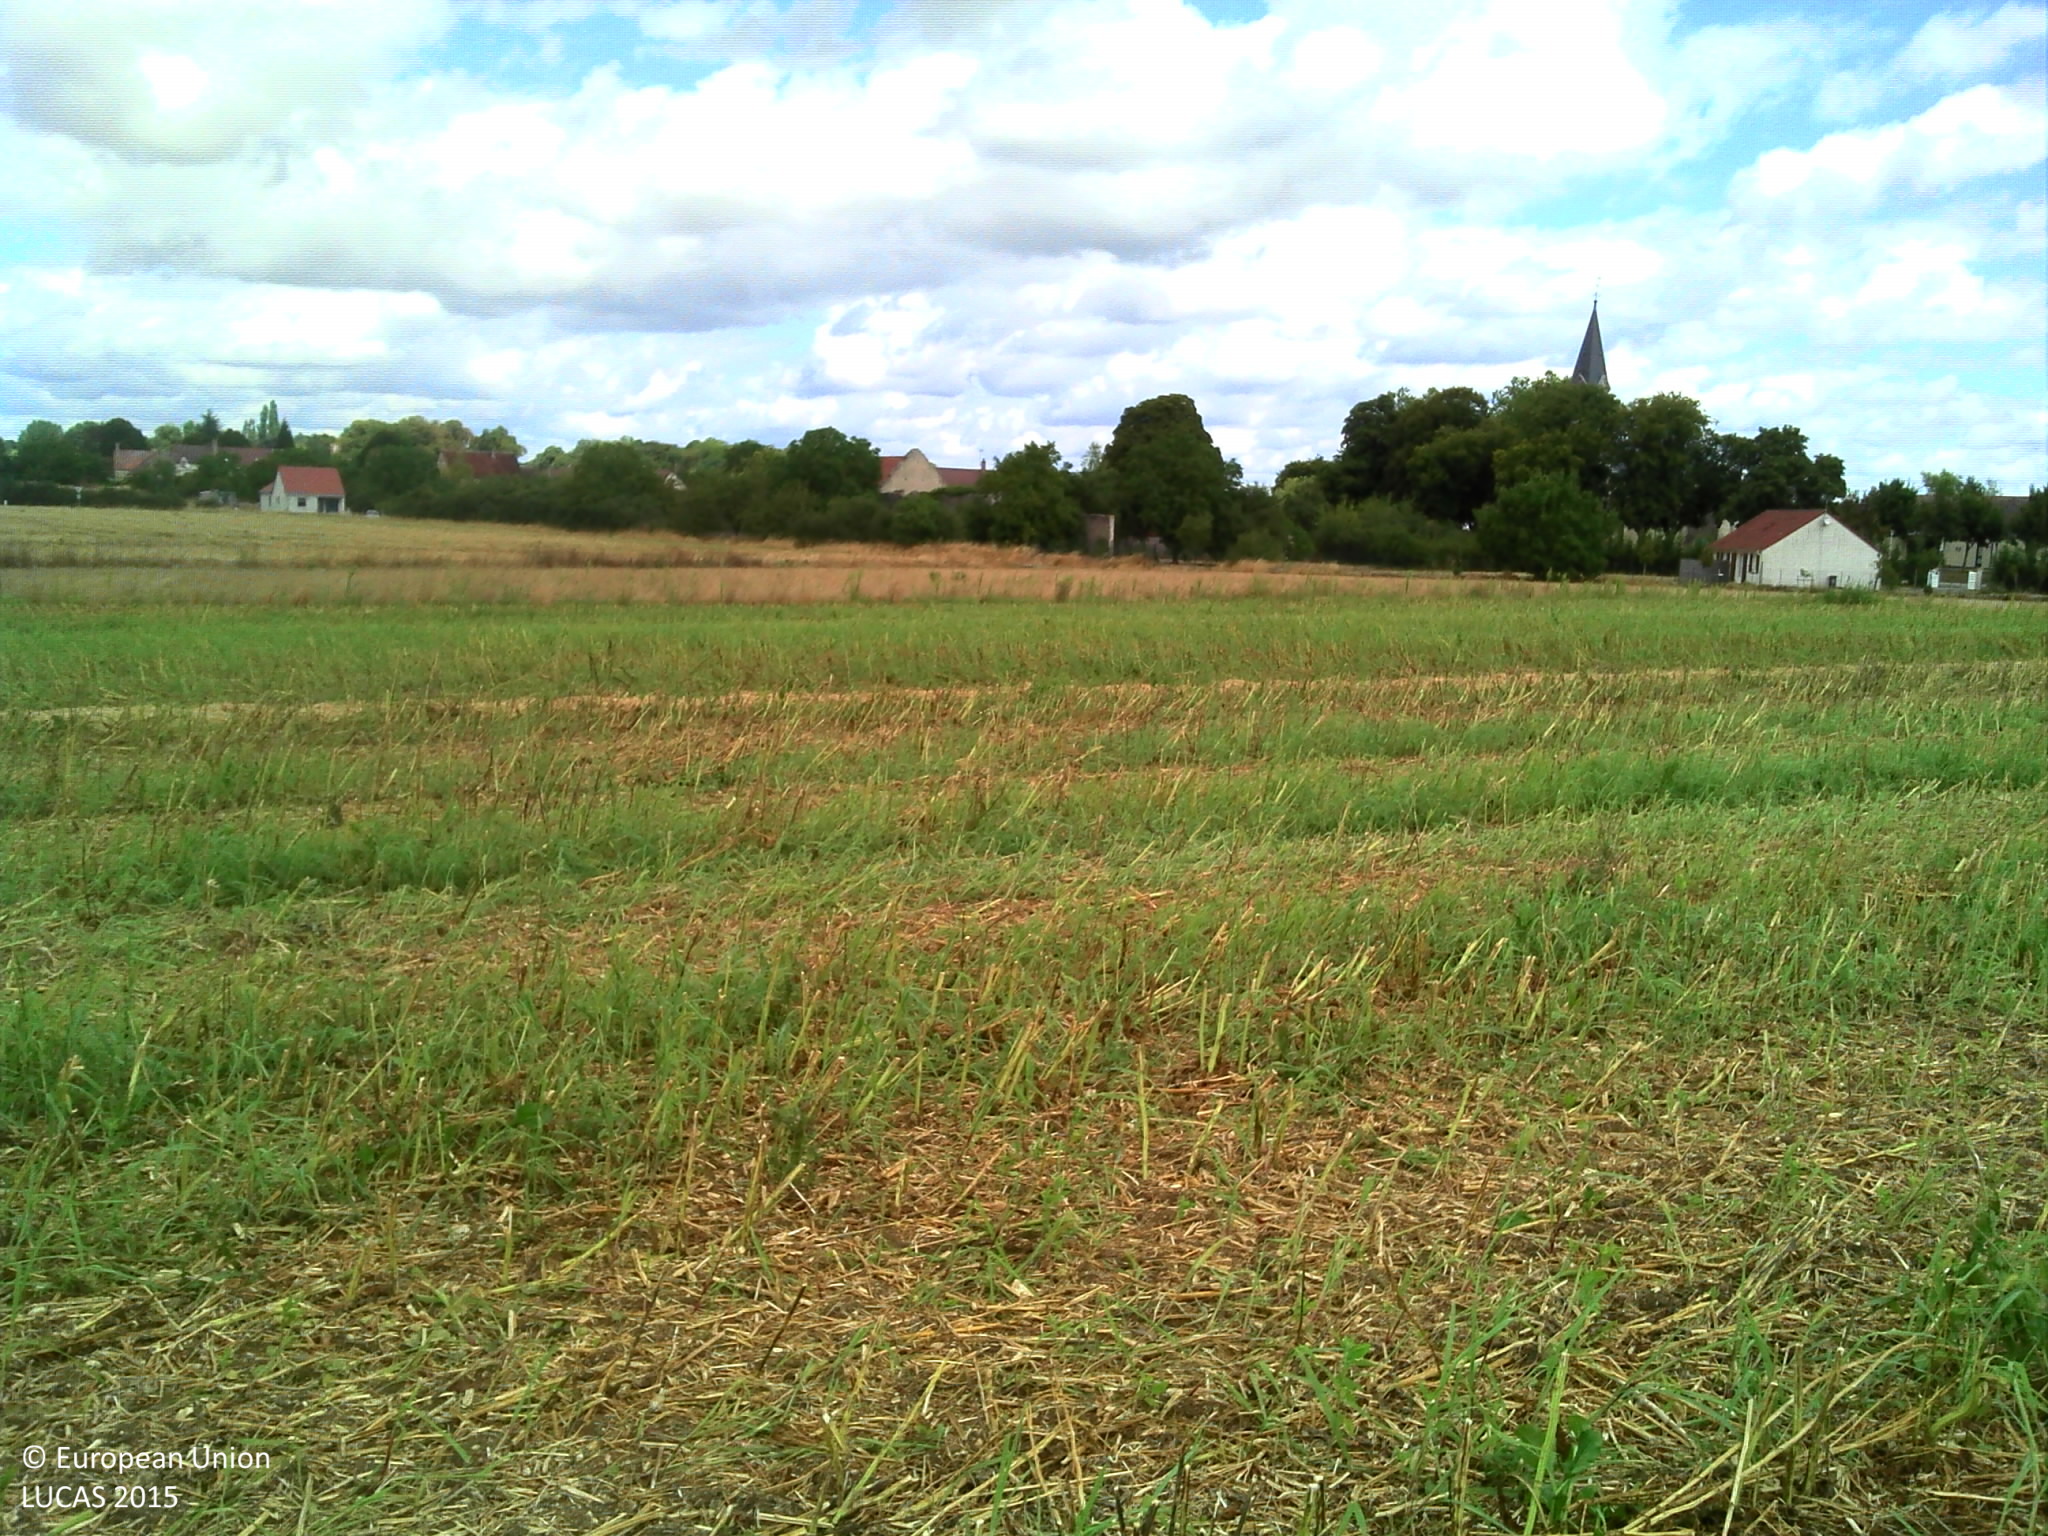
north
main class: Cropland
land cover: Rape and turnip rape
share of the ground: 25 - 50 %
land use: Agriculture (excluding fallow land and kitchen gardens)
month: August
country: FR
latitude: 47.1078
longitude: 2.0977
